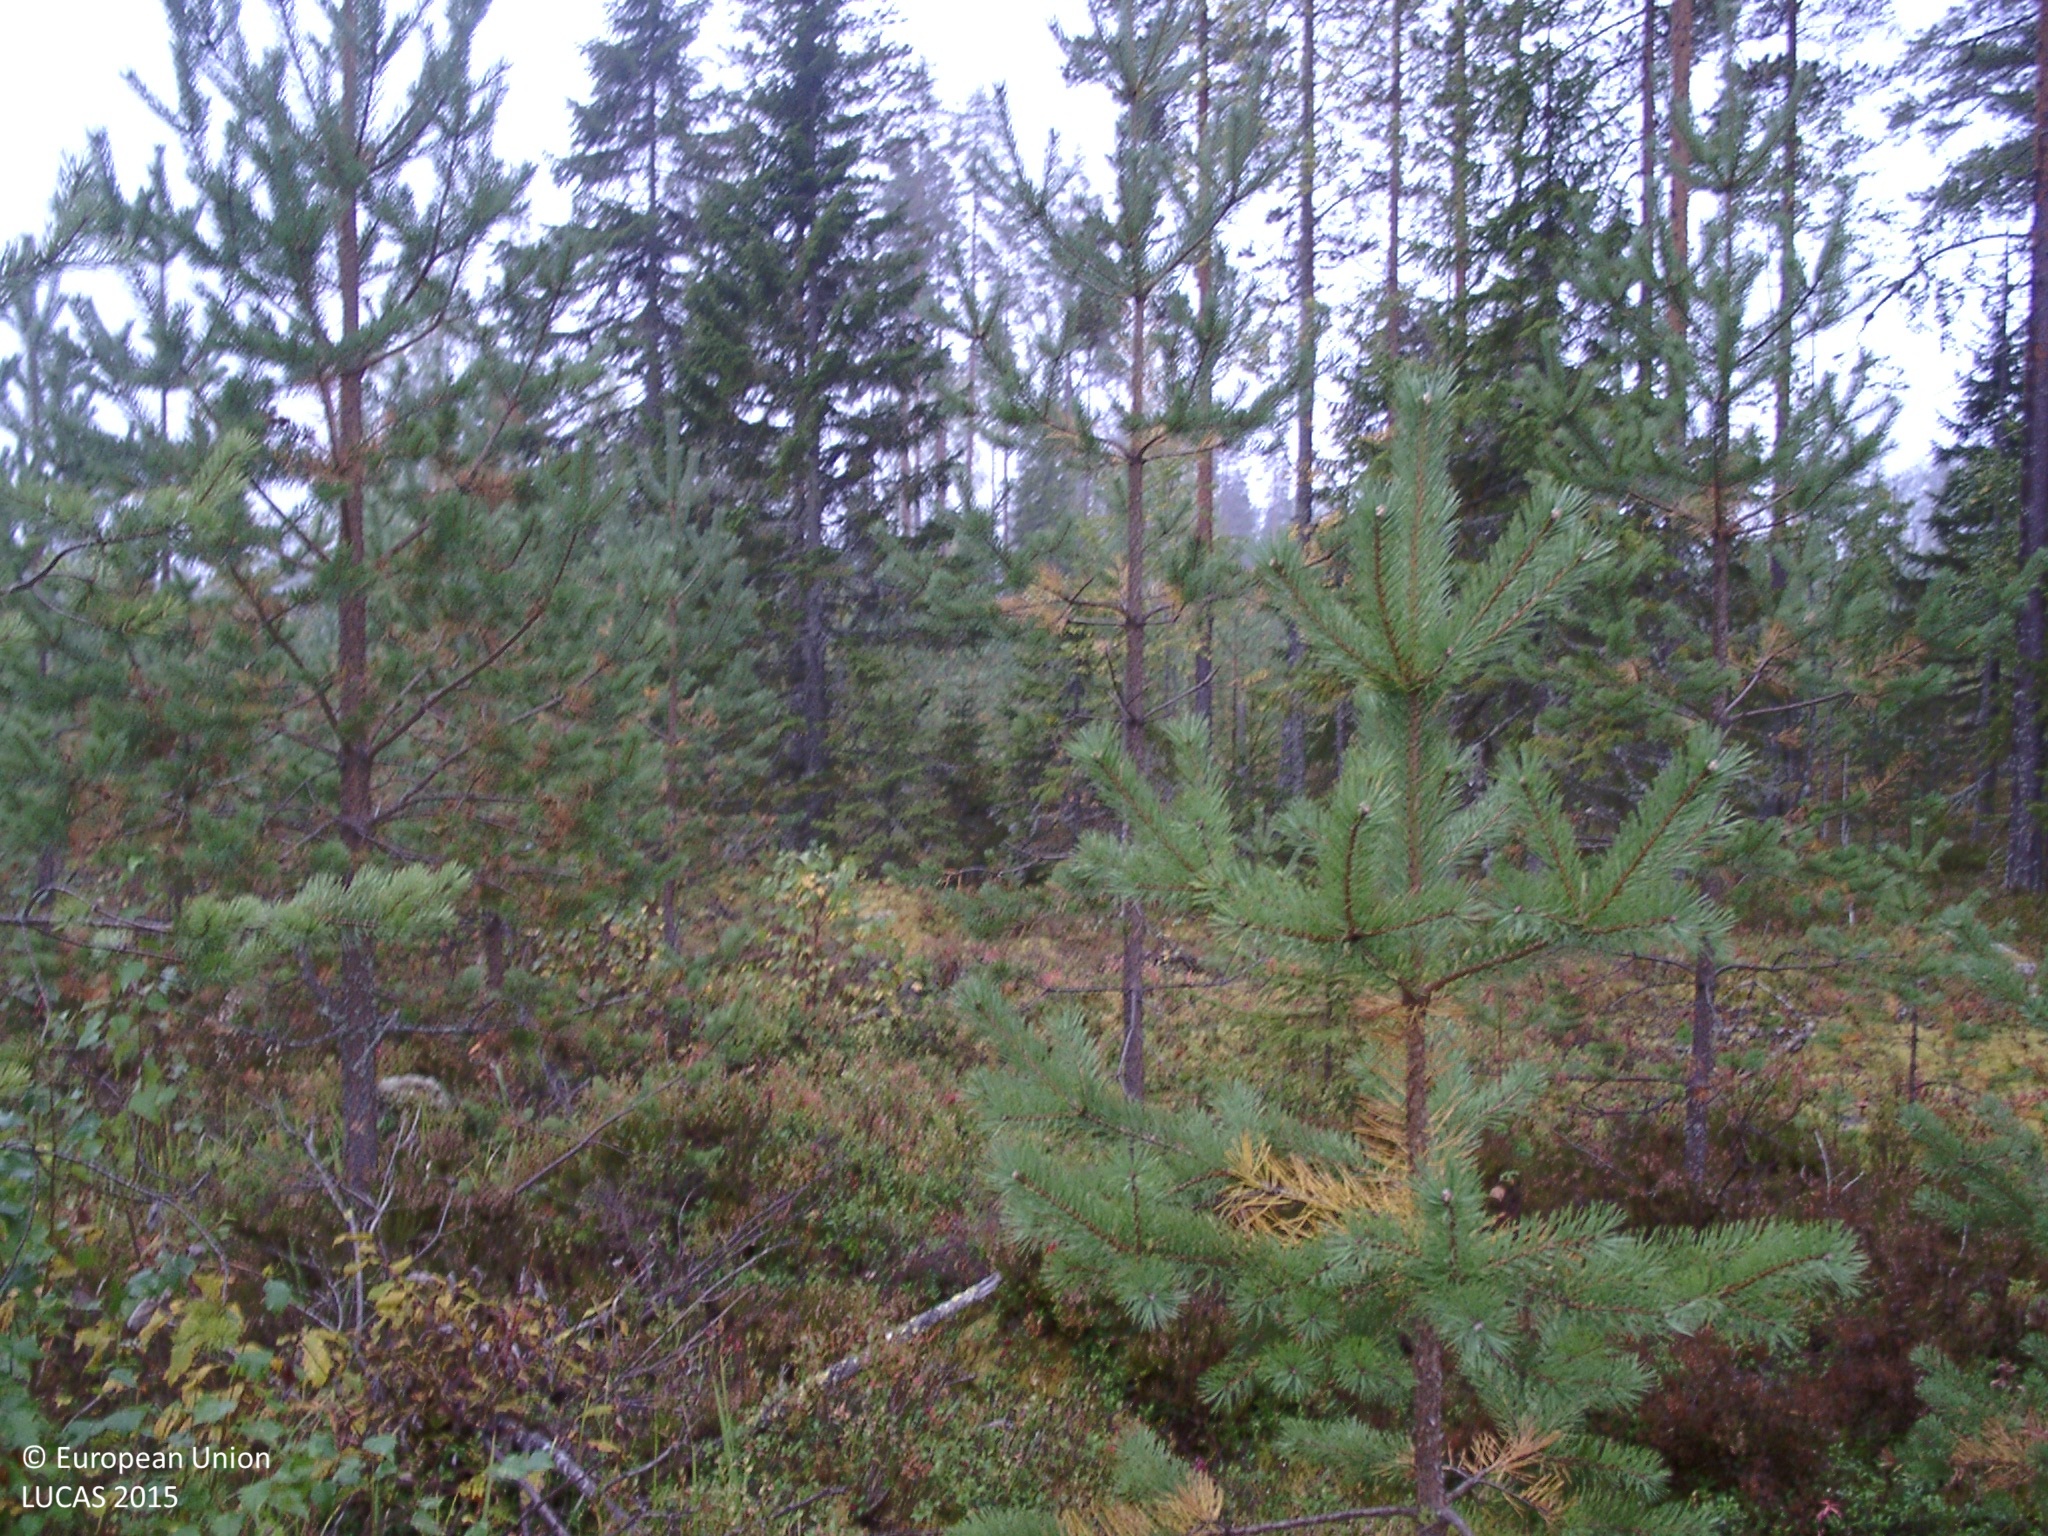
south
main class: Woodland
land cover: Pine dominated mixed woodland
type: boreal forest
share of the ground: 25 - 50 %
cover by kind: shrubs 35 %, coniferous forest trees 30 %, broadleaved forest trees 15 %, lichens and mosses 15 %, herbaceous plants 5 %
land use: Forestry
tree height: < 5 m
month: September
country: FI
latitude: 62.7086
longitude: 25.6550
